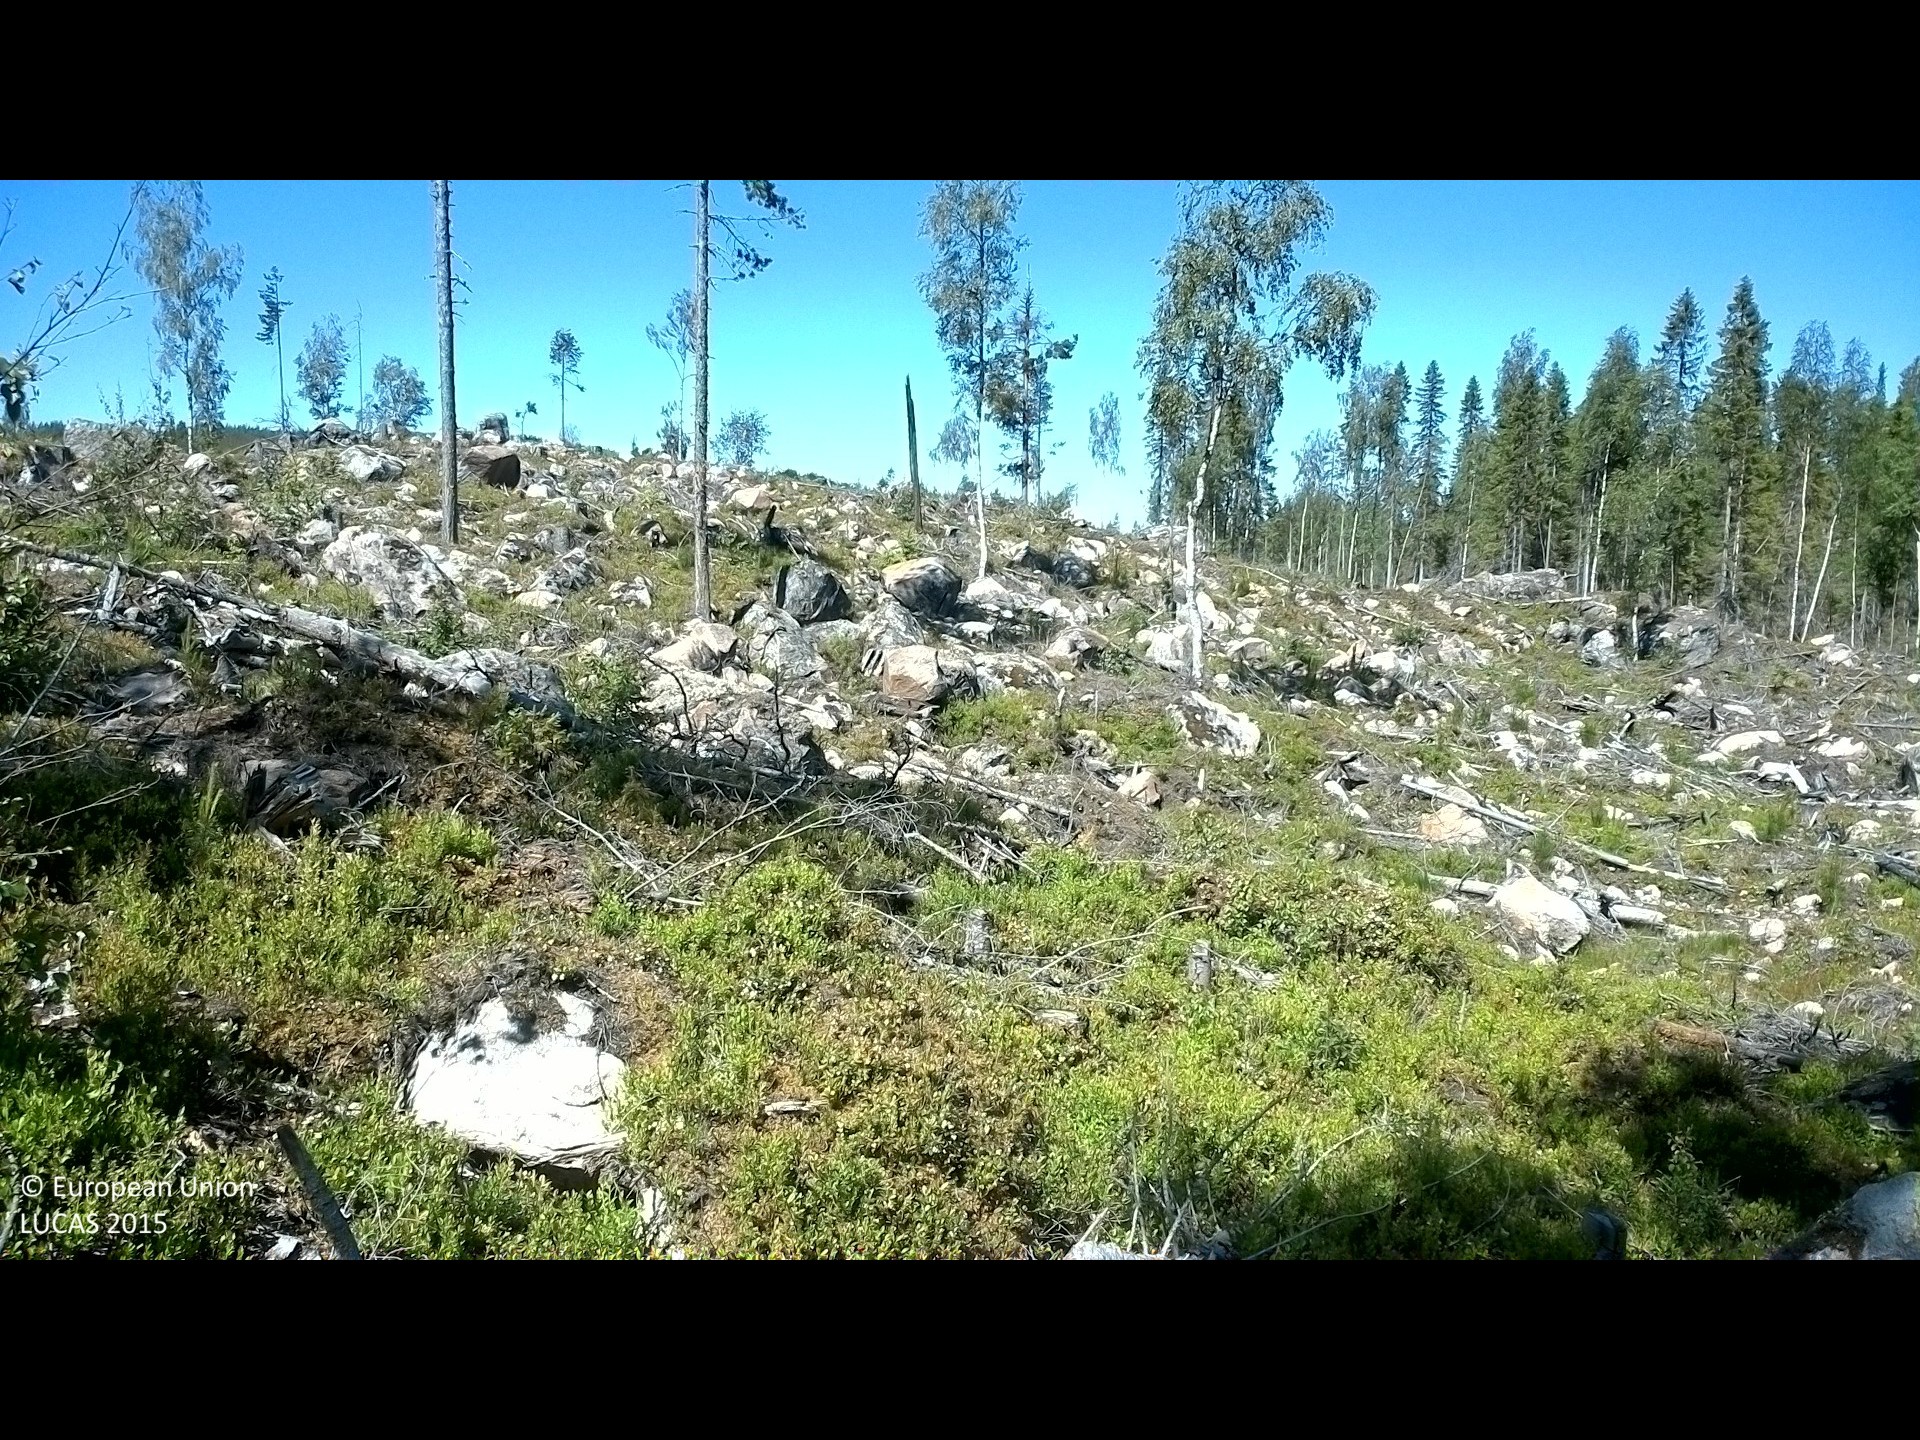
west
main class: Woodland
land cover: Spruce dominated coniferous woodland
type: boreal forest
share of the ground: 10 - 25 %
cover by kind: shrubs 55 %, coniferous forest trees 20 %, lichens and mosses 20 %, broadleaved forest trees 5 %
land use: Forestry
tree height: > 5 m
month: June
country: SE
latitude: 62.0148
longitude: 16.1900
